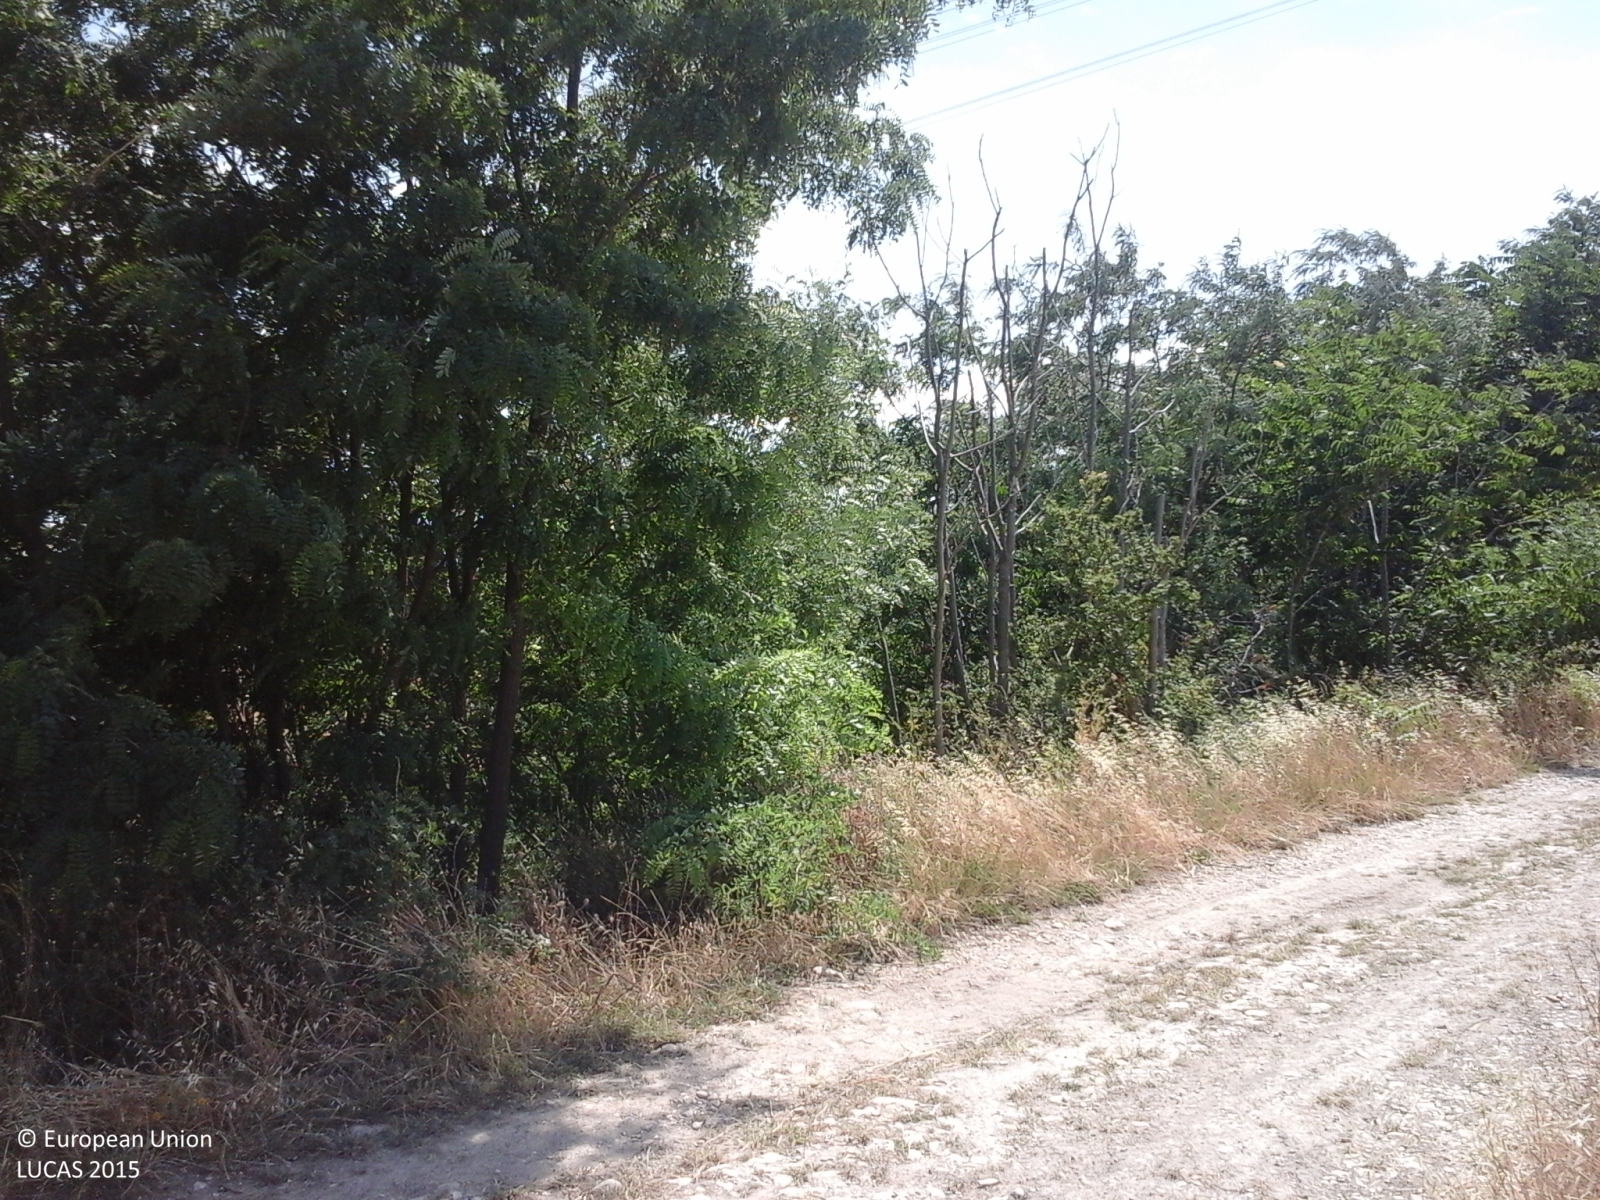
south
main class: Cropland
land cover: Other non-permanent industrial crops
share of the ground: > 75 %
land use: Agriculture (excluding fallow land and kitchen gardens)
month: June
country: IT
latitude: 42.2006
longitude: 14.3102
